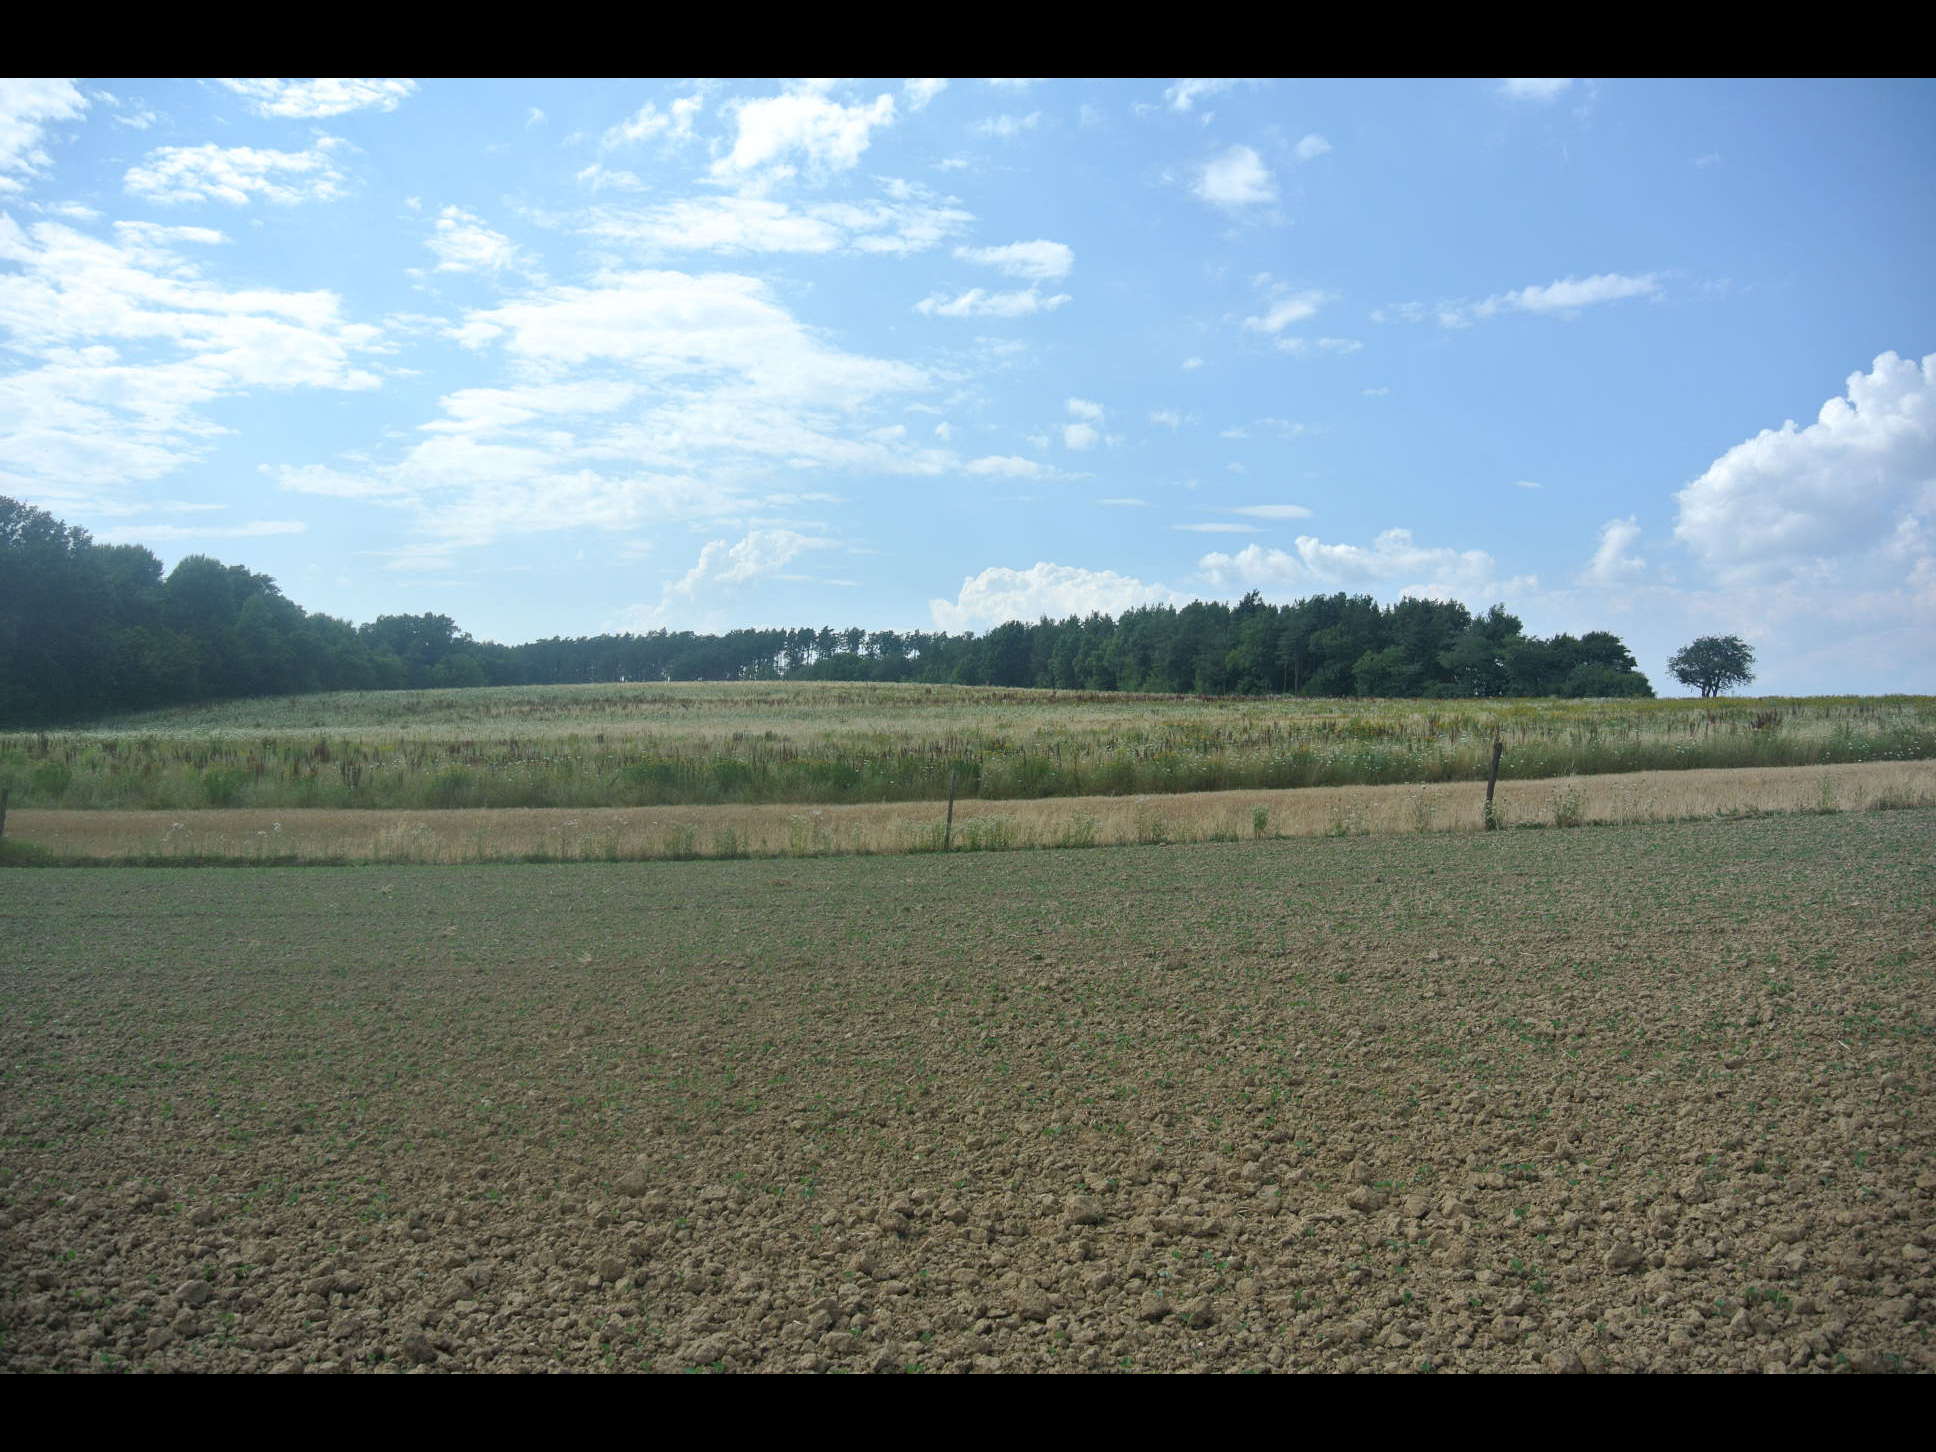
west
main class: Cropland
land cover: Apple fruit
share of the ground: < 10 %
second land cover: Grassland without tree/shrub cover
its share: > 75 %
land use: Agriculture (excluding fallow land and kitchen gardens)
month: July
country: AT
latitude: 47.4187
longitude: 16.4852
